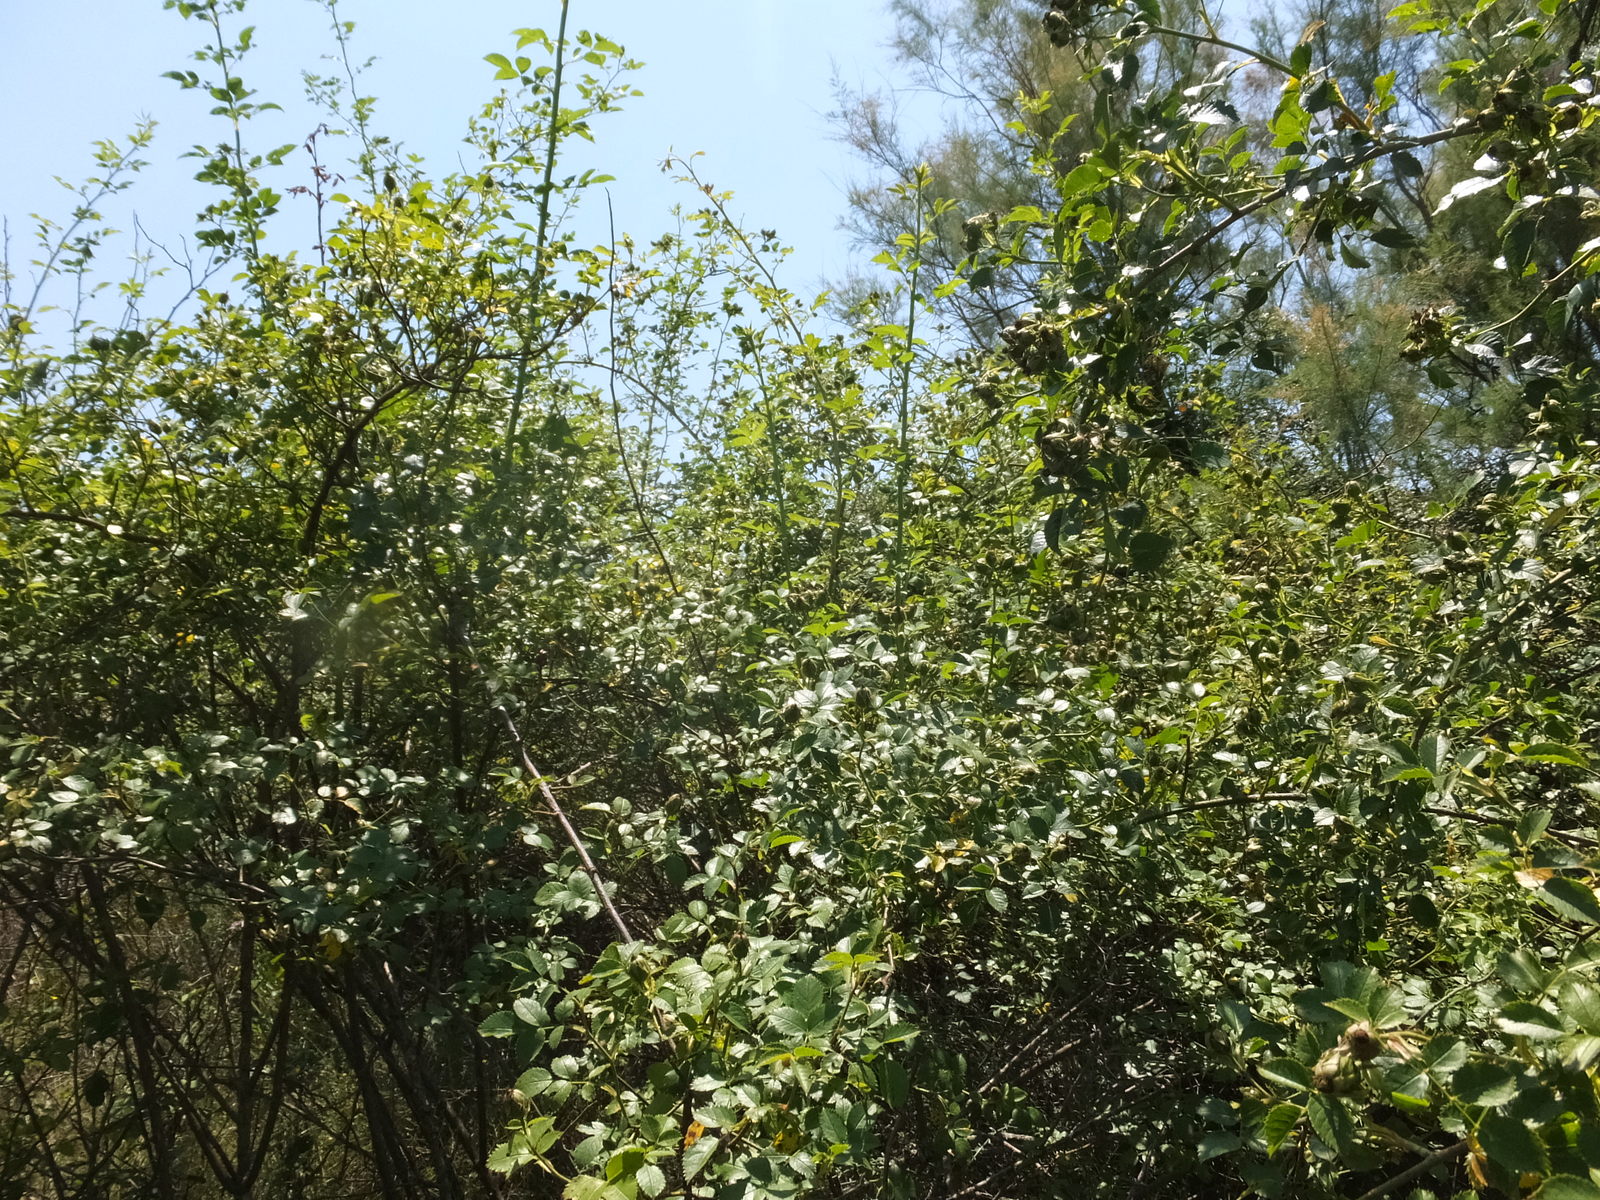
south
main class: Shrubland
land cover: Shrubland with sparse tree cover
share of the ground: 50 - 75 %
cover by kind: shrubs 70 %, herbaceous plants 25 %, broadleaved forest trees 5 %
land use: Semi-natural and natural areas not in use
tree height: < 5 m
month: June
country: ES
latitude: 41.9043
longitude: 0.5704
